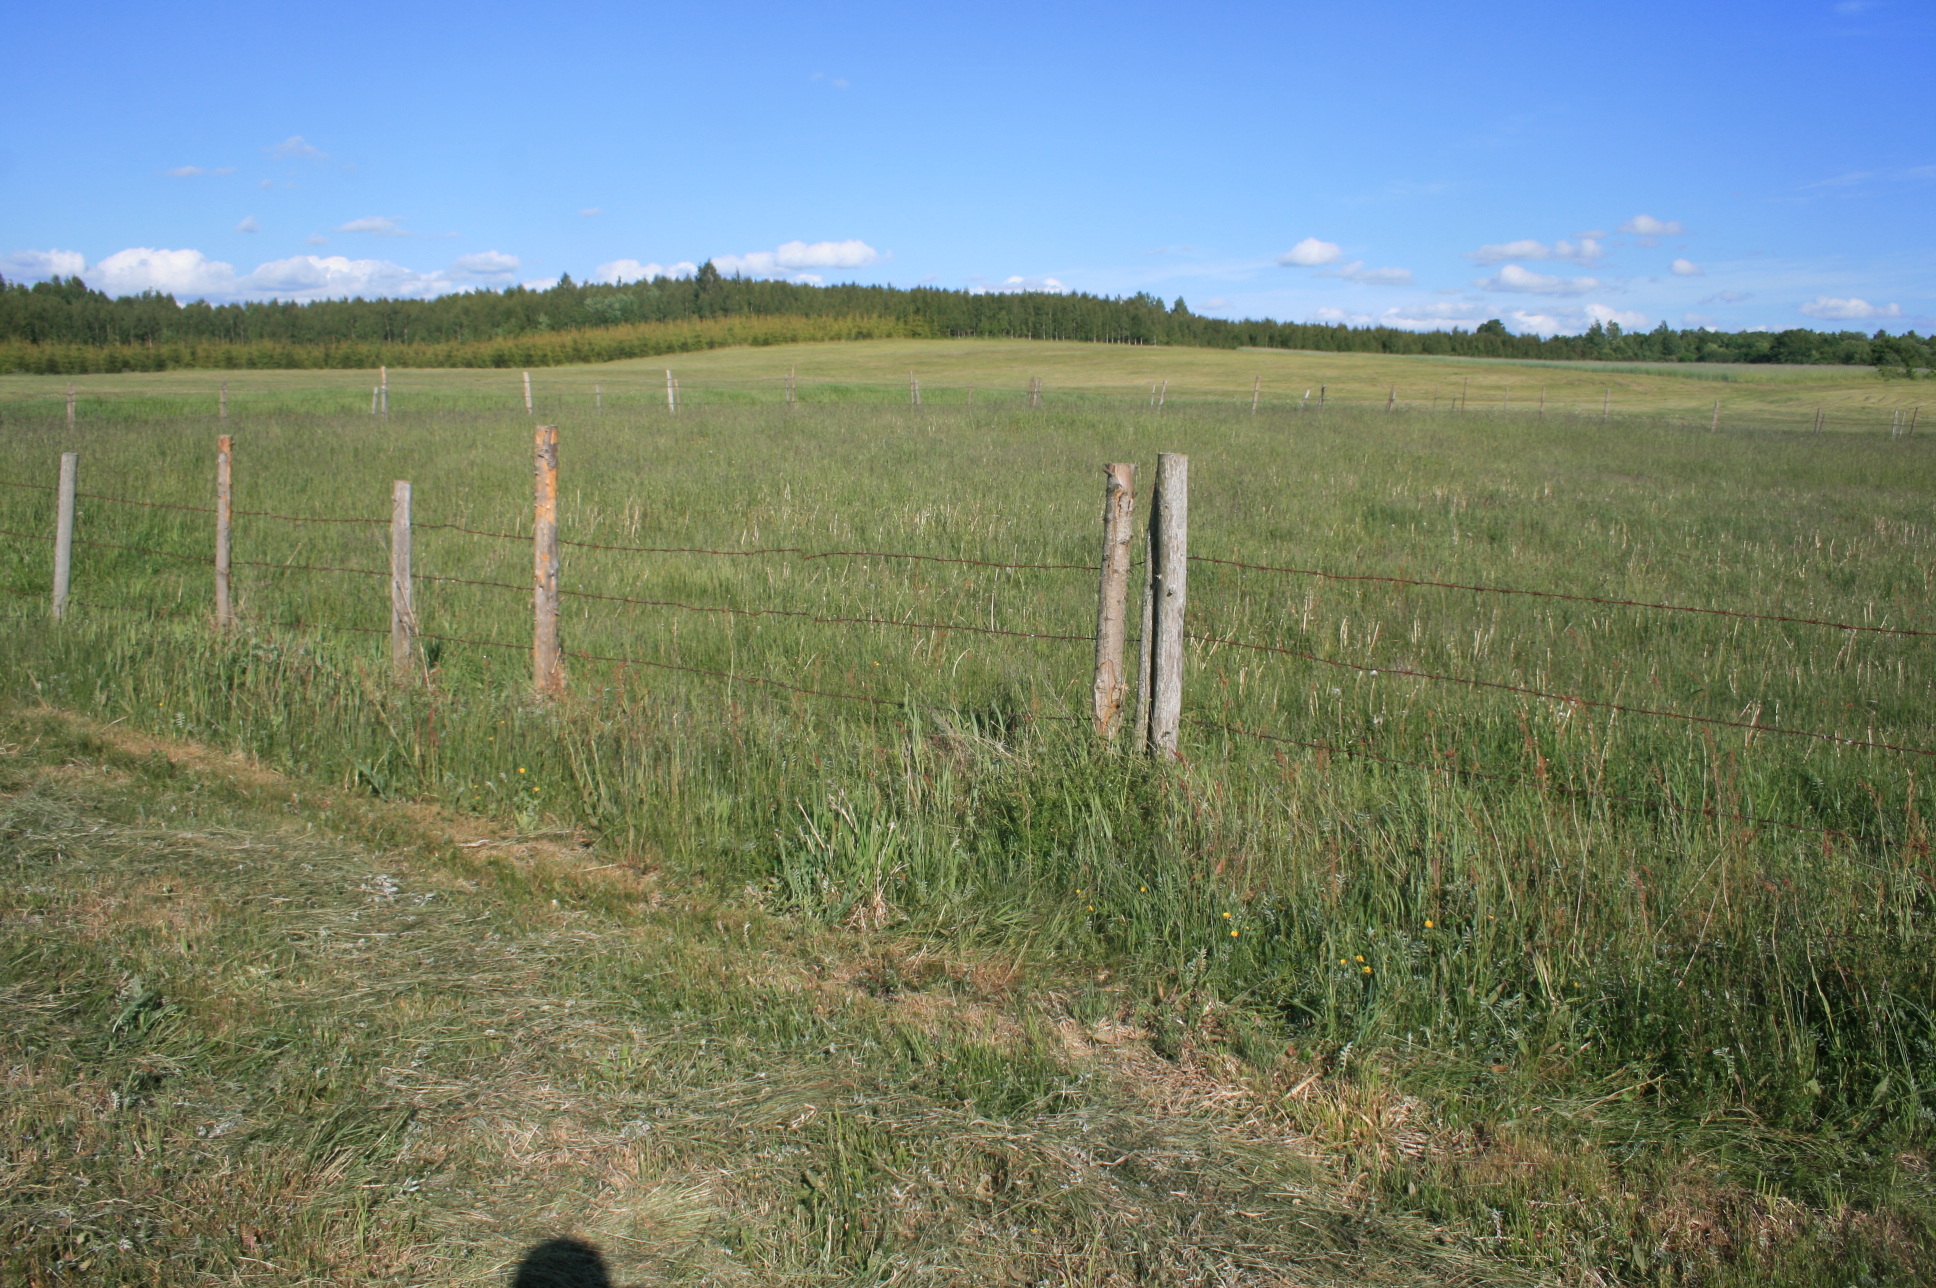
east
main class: Grassland
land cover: Grassland without tree/shrub cover
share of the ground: > 75 %
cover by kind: herbaceous plants 100 %
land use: Agriculture (excluding fallow land and kitchen gardens)
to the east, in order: Grassland without tree/shrub cover; Fences; Grassland without tree/shrub cover; Fences; Spontaneously vegetated surfaces; Ditches and canals; Spontaneously vegetated surfaces; Grassland without tree/shrub cover; Spruce dominated coniferous woodland
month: June
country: LT
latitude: 55.8206
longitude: 22.3959
